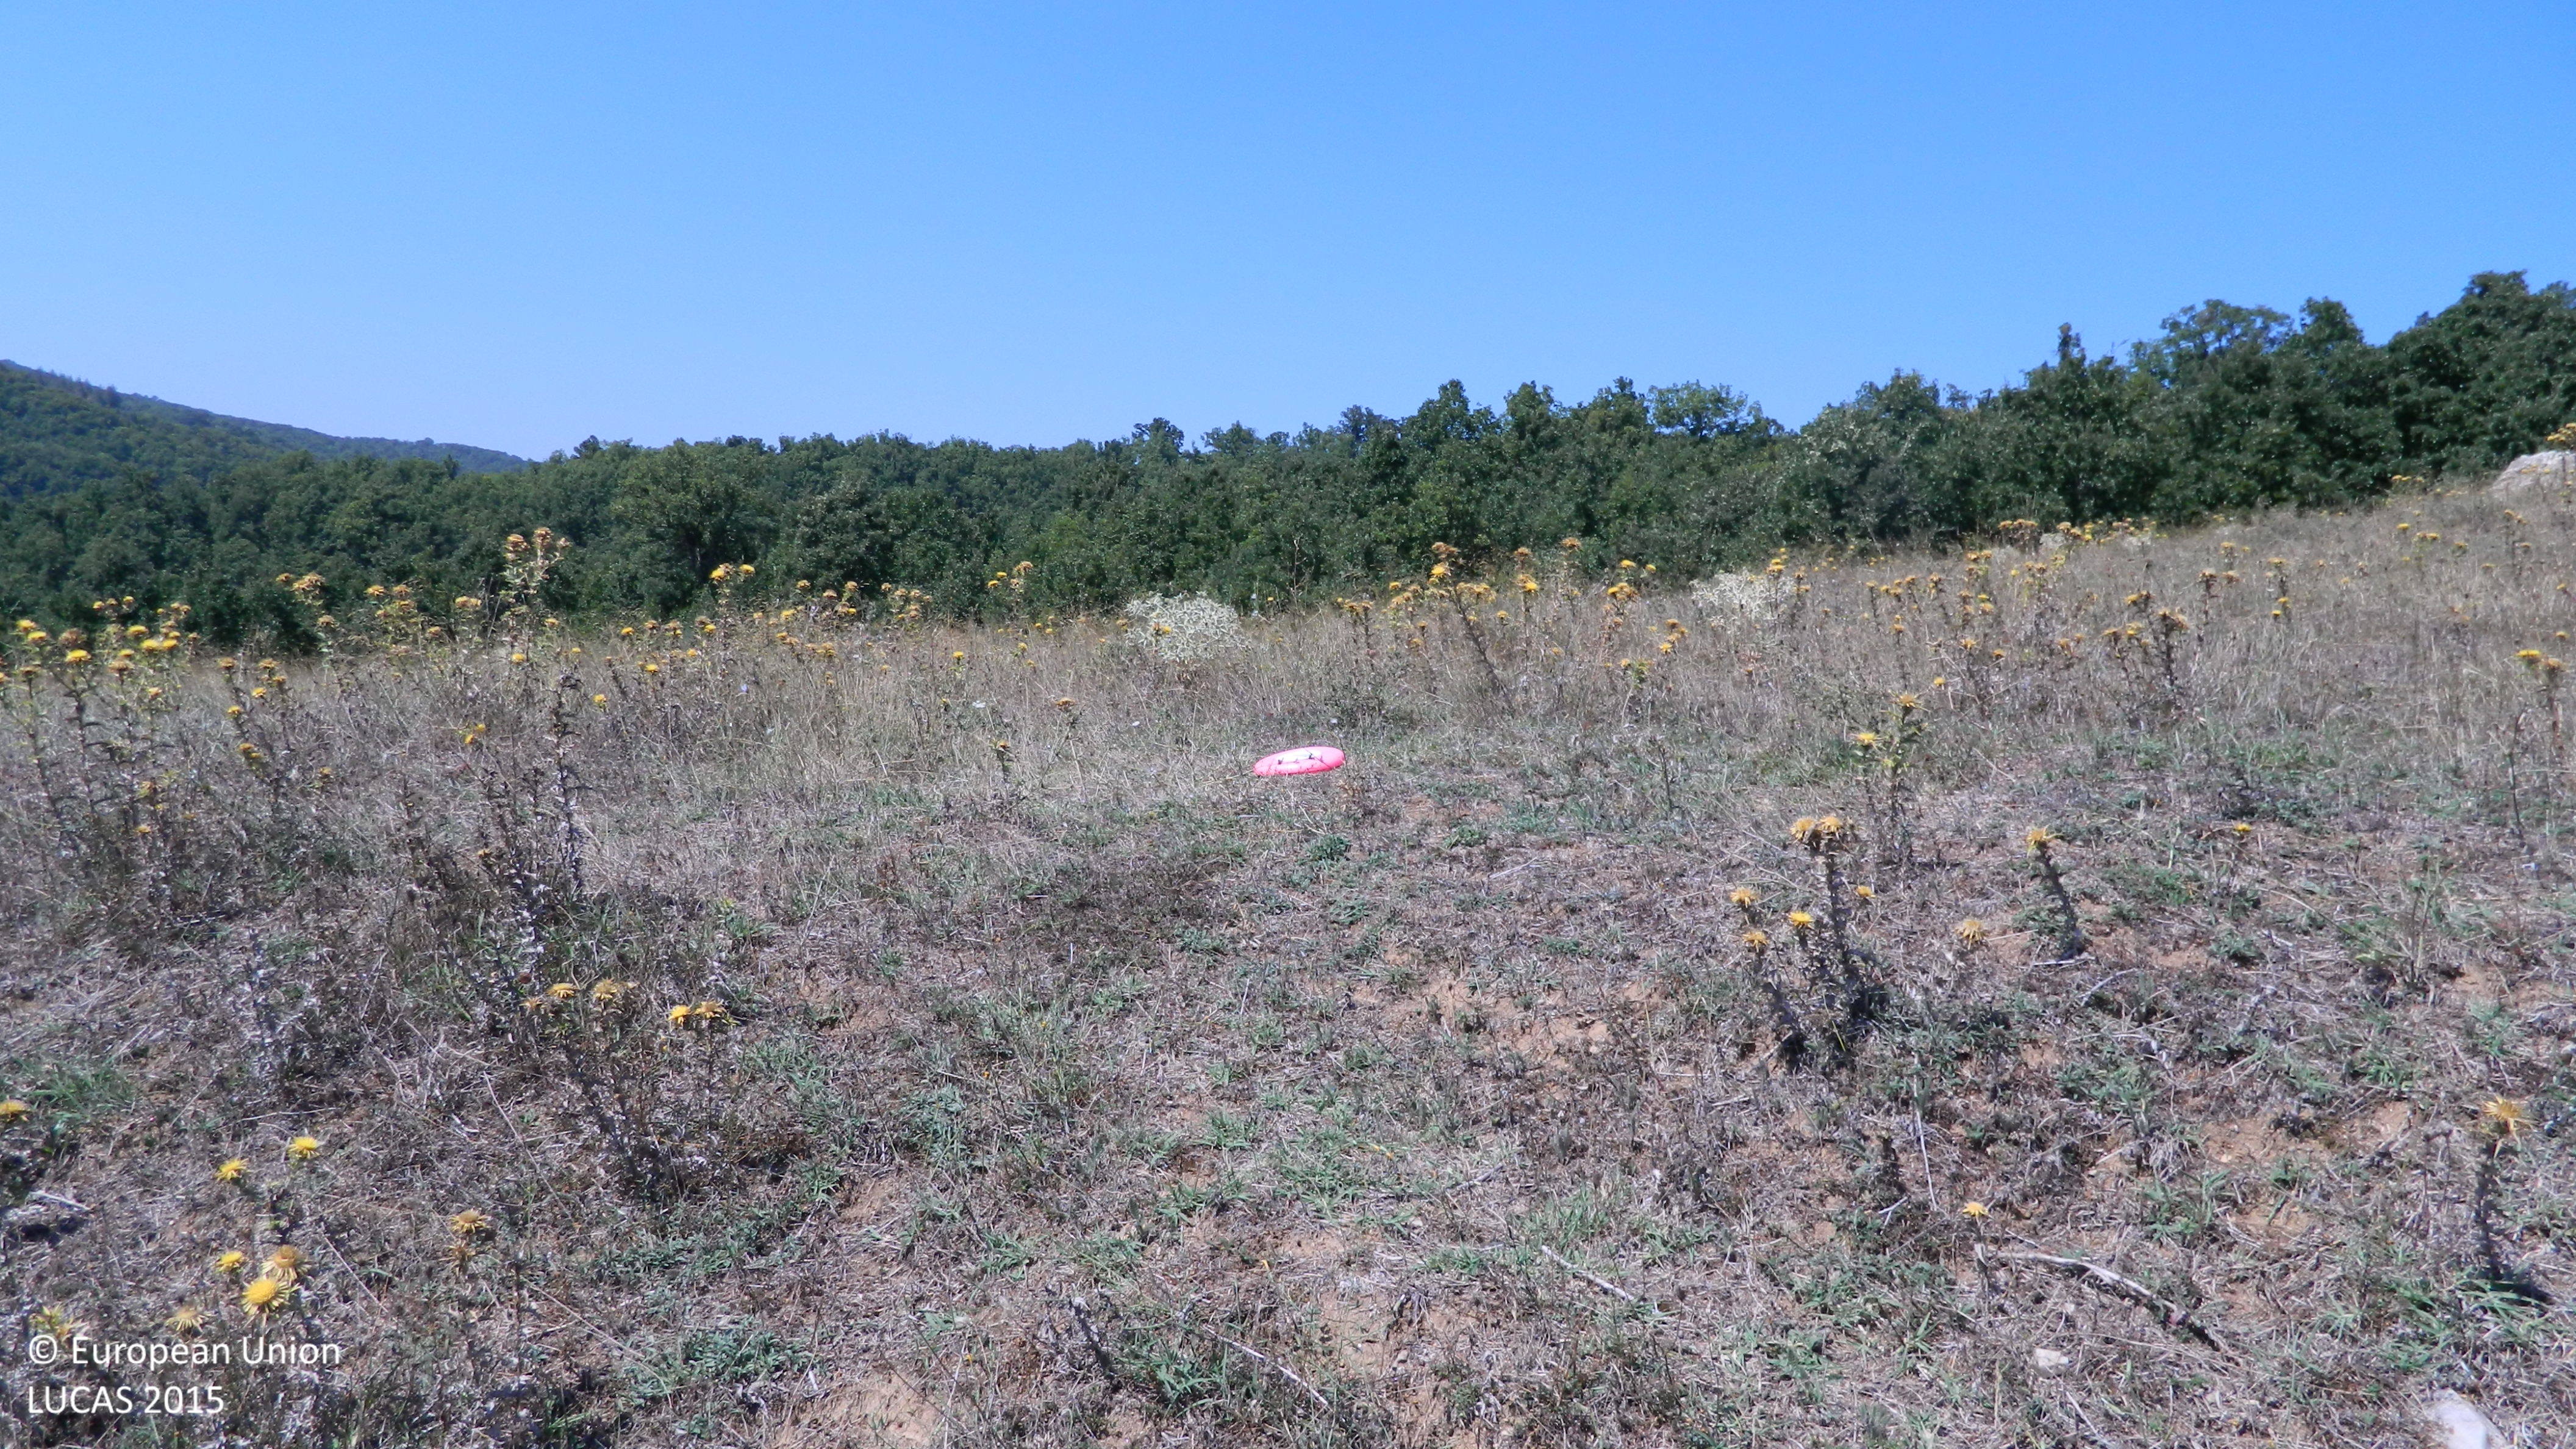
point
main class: Grassland
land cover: Grassland without tree/shrub cover
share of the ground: > 75 %
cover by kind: herbaceous plants 95 %, shrubs 5 %
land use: Agriculture (excluding fallow land and kitchen gardens)
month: August
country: BG
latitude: 41.5357
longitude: 25.8997
